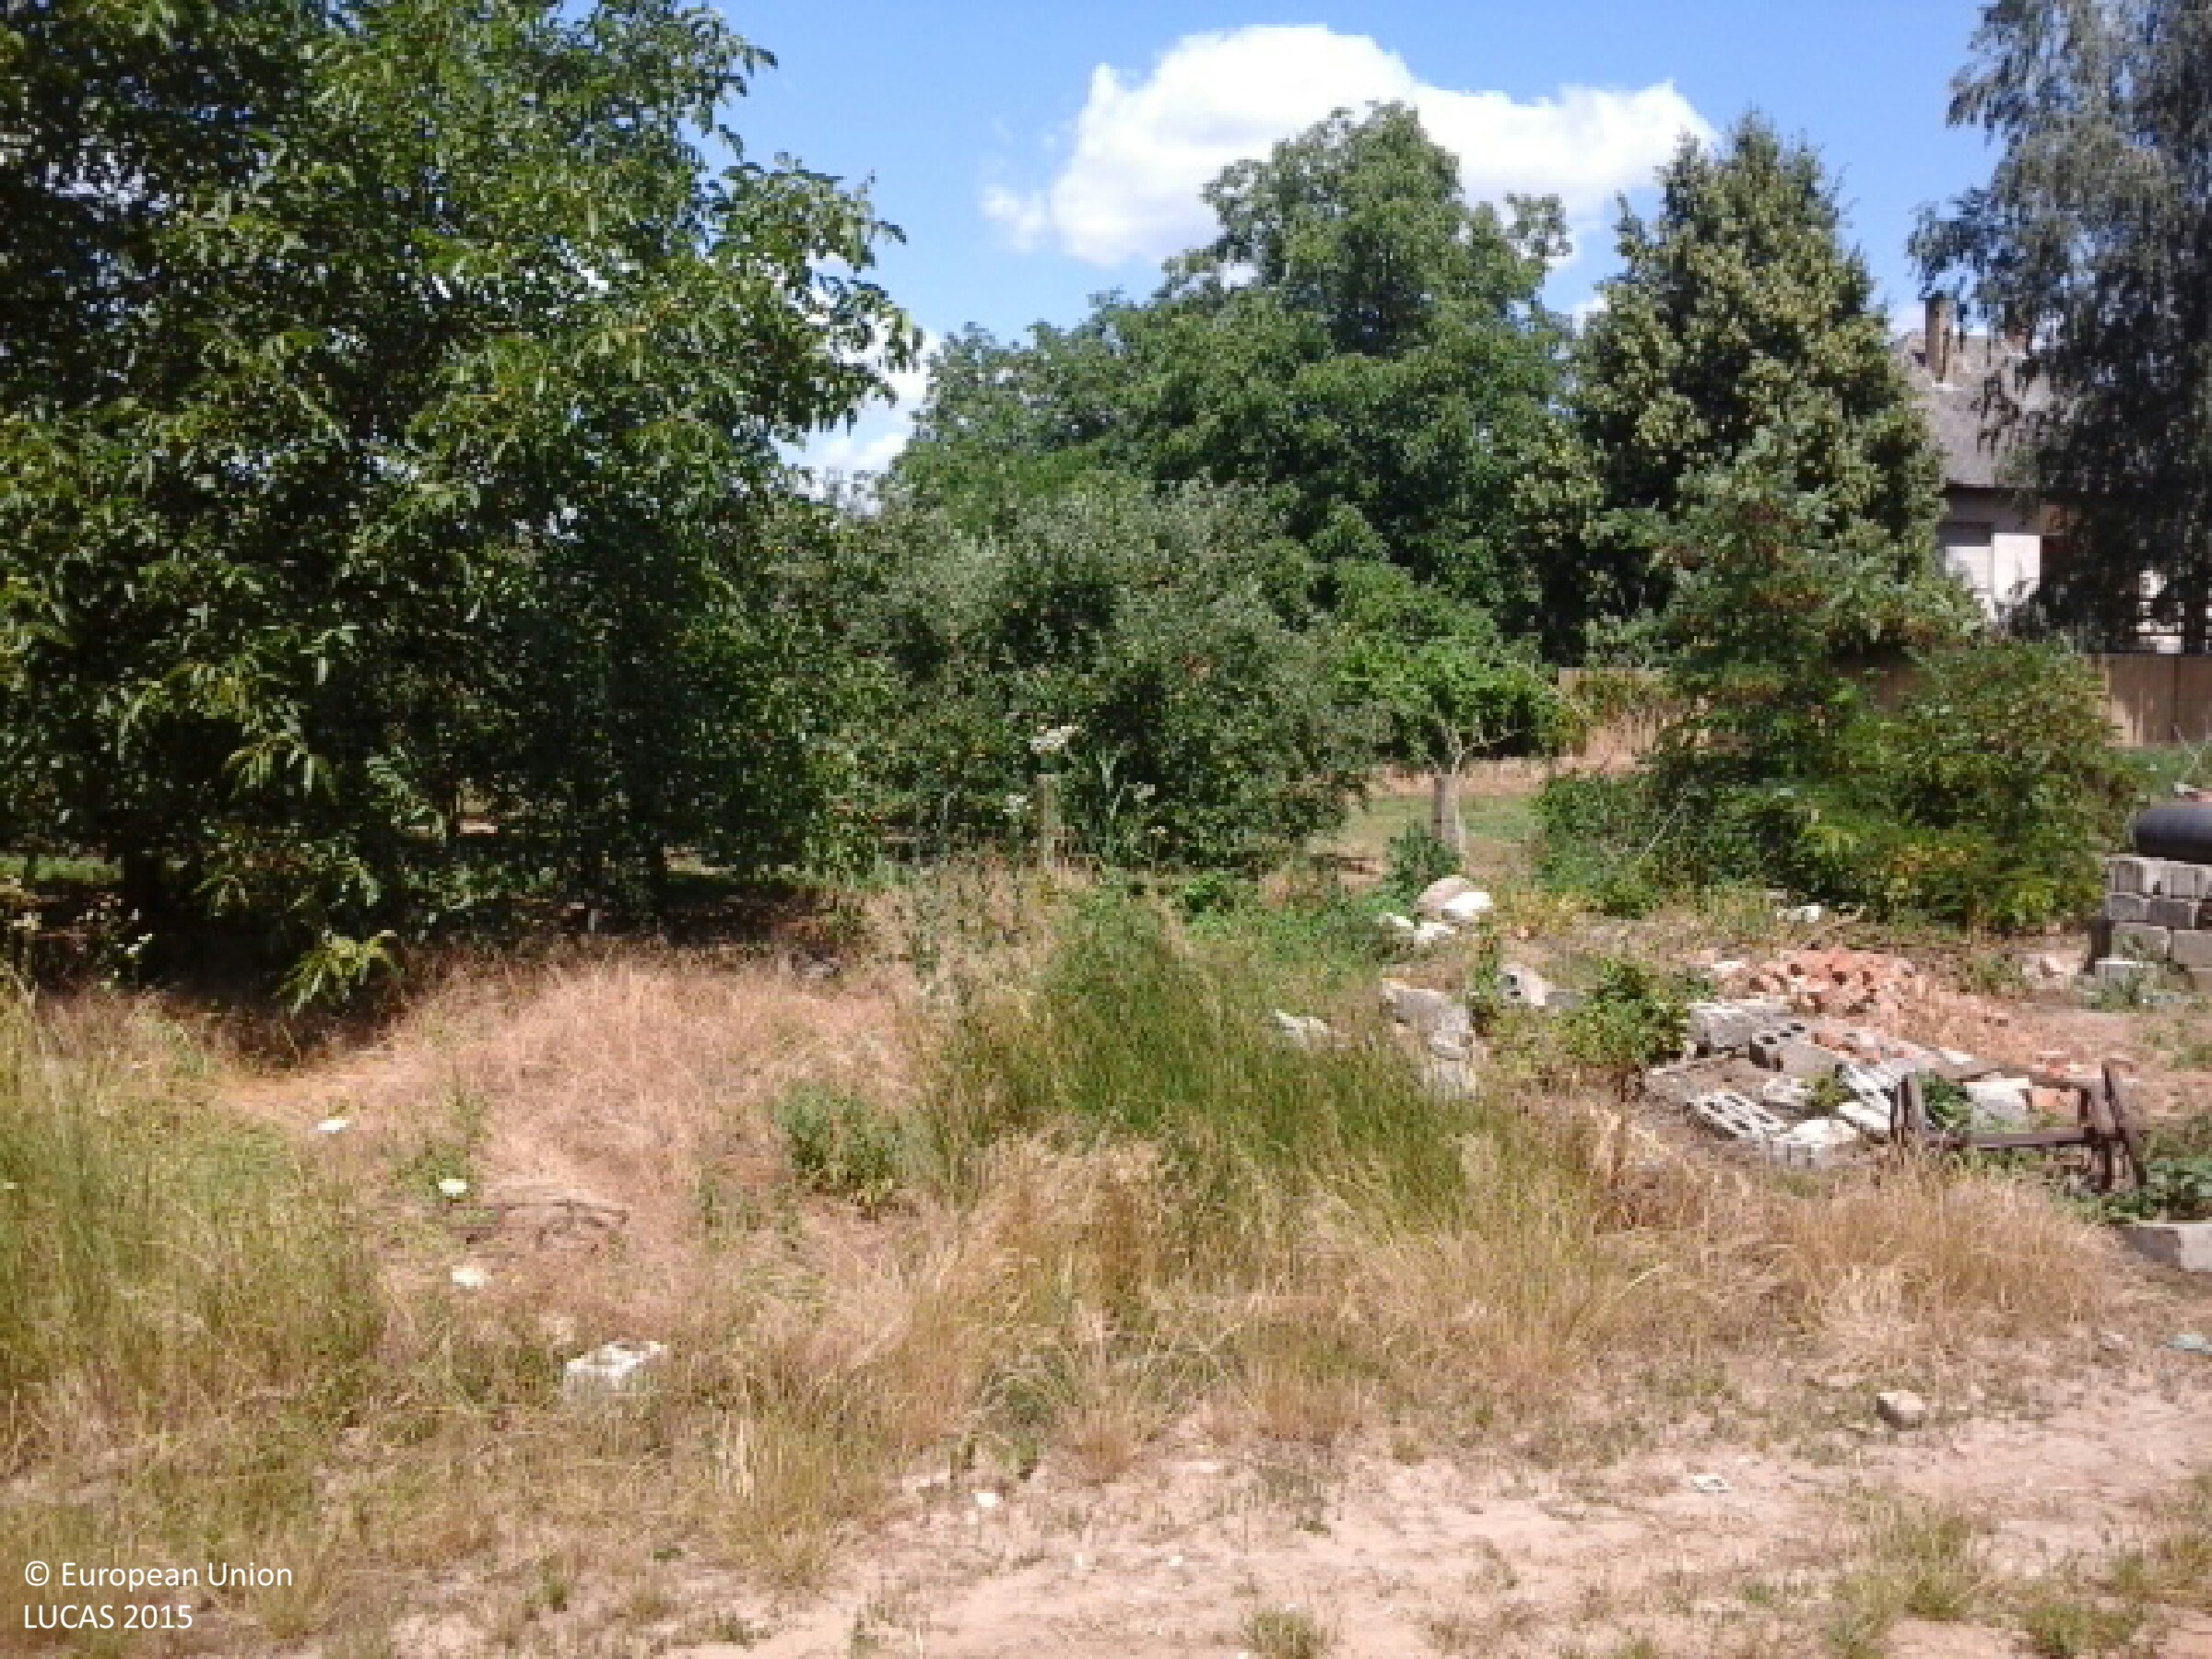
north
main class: Grassland
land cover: Spontaneously vegetated surfaces
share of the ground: > 75 %
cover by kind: unconsolidated bare surface 80 %, herbaceous plants 20 %
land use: Residential
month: July
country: HU
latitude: 48.2683
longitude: 22.0580
